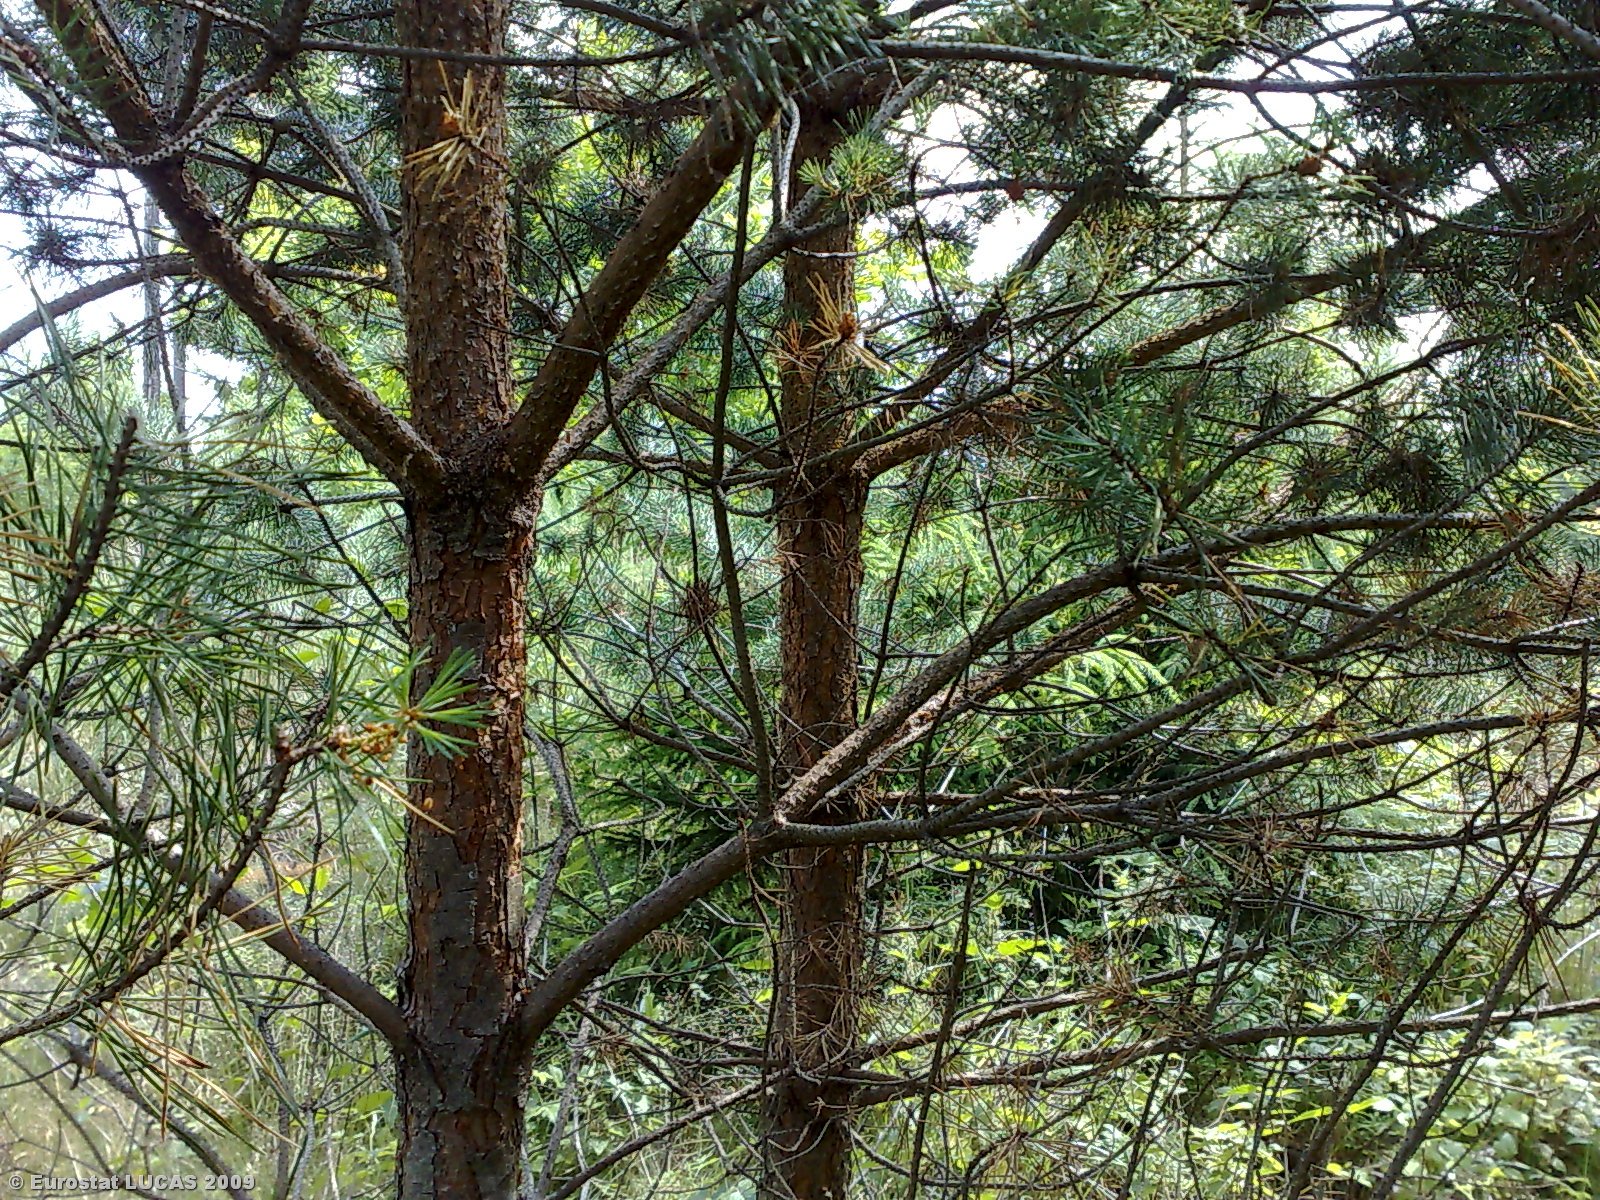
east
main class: Woodland
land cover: Coniferous woodland
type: hemiboreal forest and nemoral coniferous forest and mixed broadleaved-coniferous forest
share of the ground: > 75 %
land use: Forestry
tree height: > 5 m
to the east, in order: Coniferous woodland; Tracks; Mixed woodland; Grassland without tree/shrub cover
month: July
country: LT
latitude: 55.5618
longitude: 22.7979
